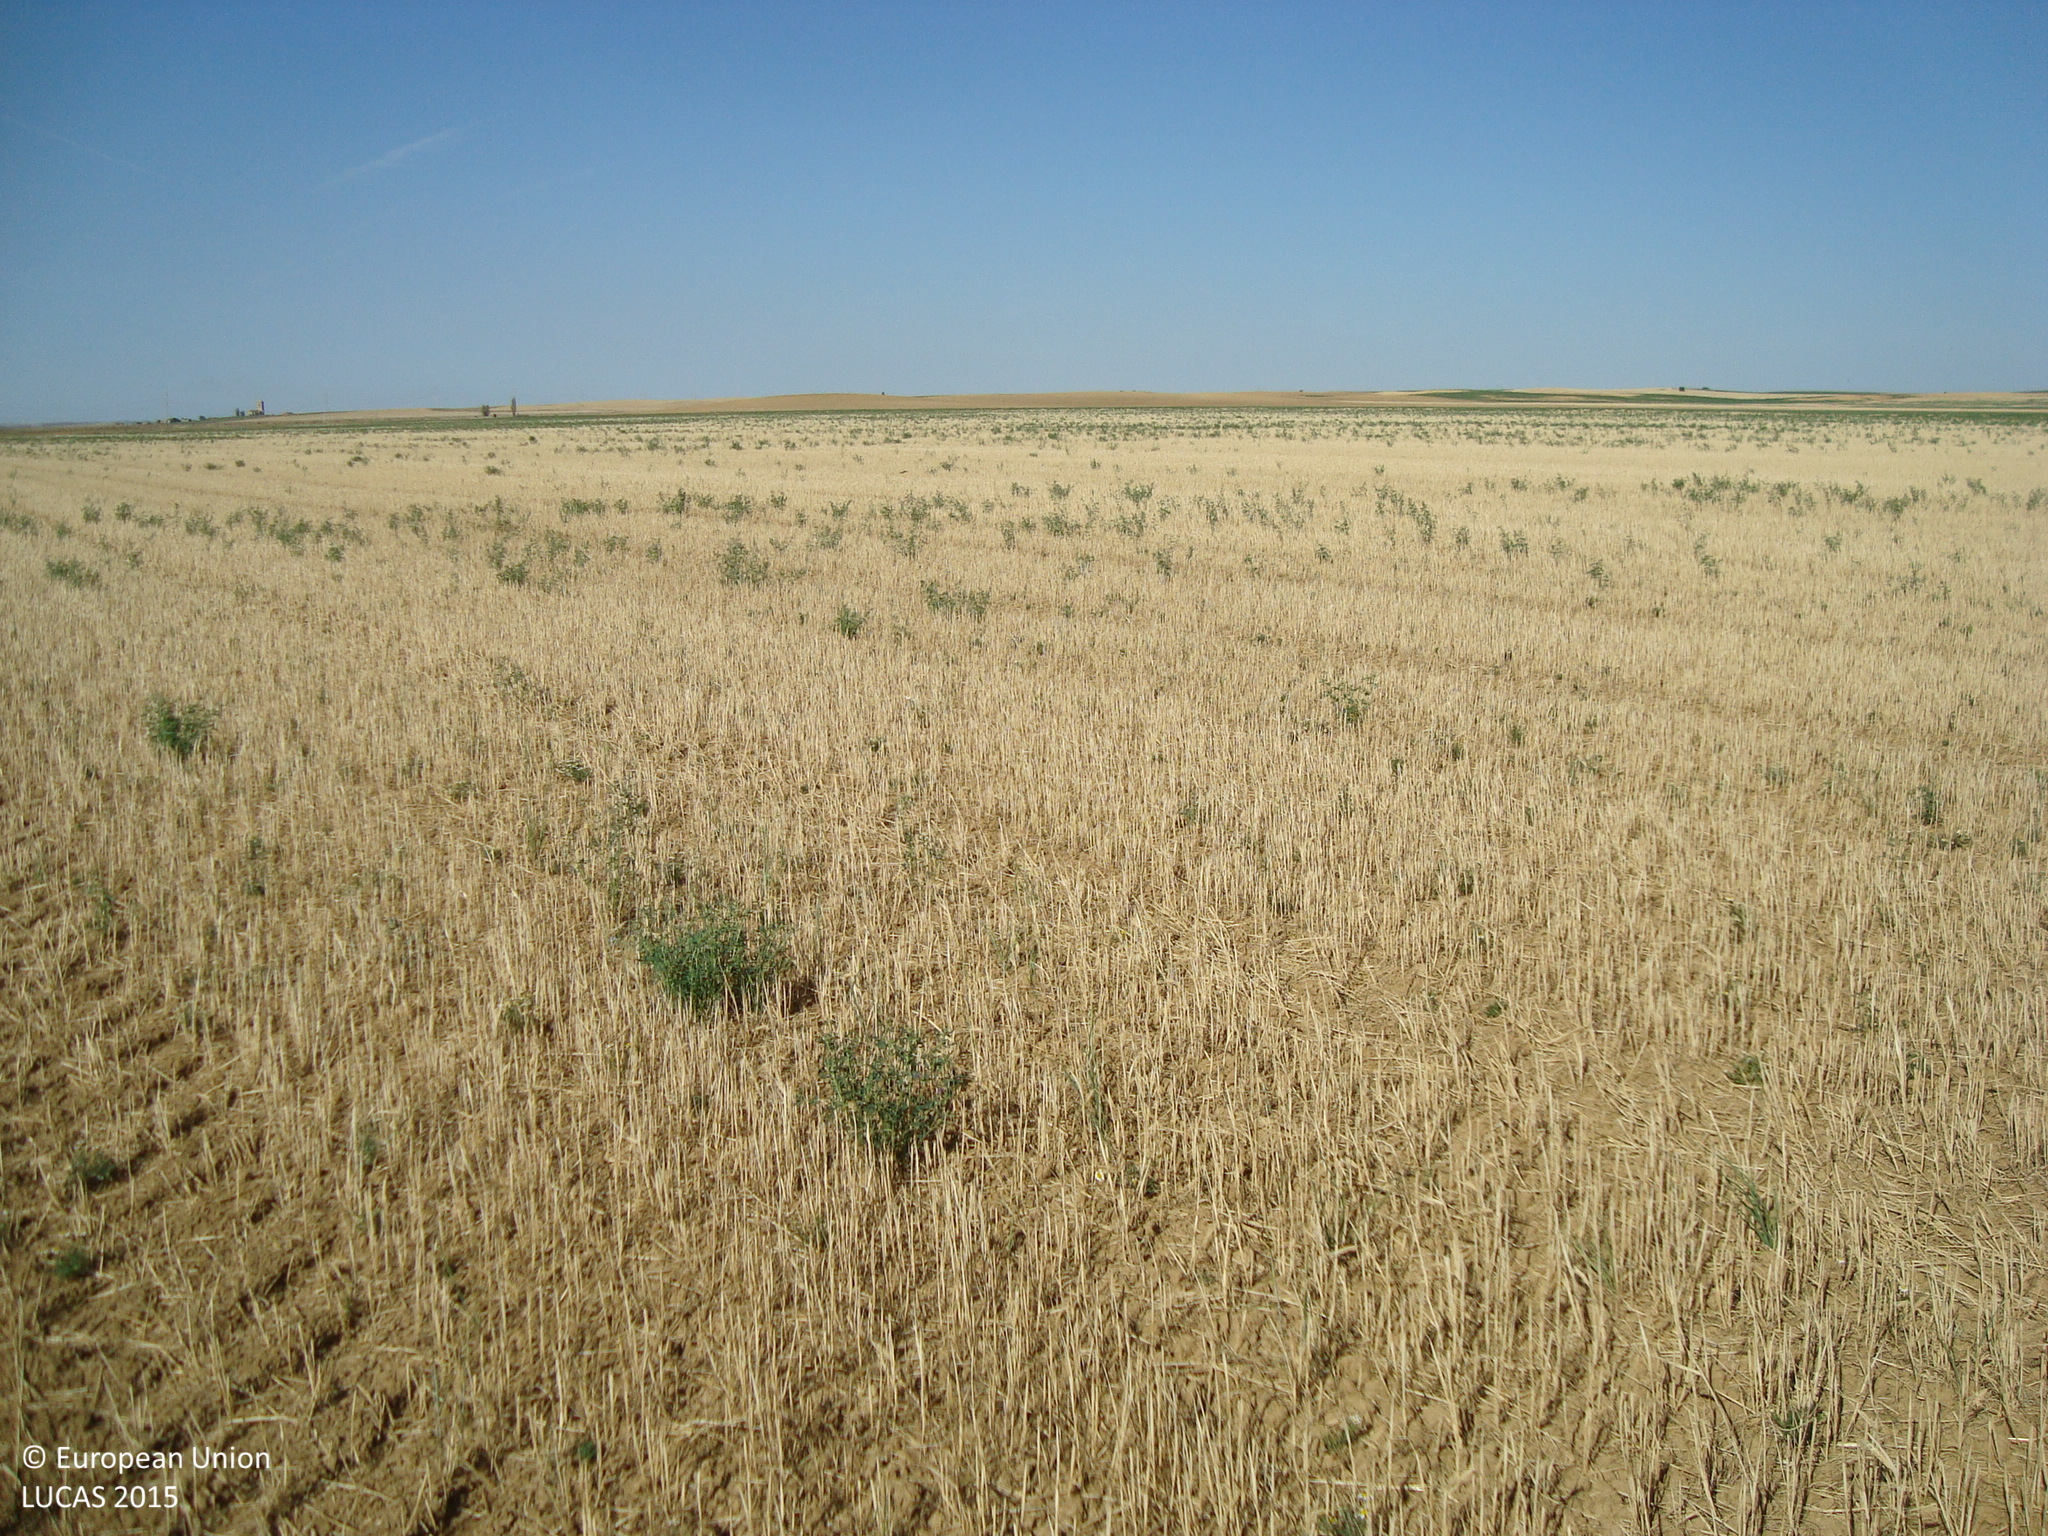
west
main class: Cropland
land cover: Barley
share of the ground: < 10 %
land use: Agriculture (excluding fallow land and kitchen gardens)
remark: Harvested field
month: July
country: ES
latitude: 42.0434
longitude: -4.7529
